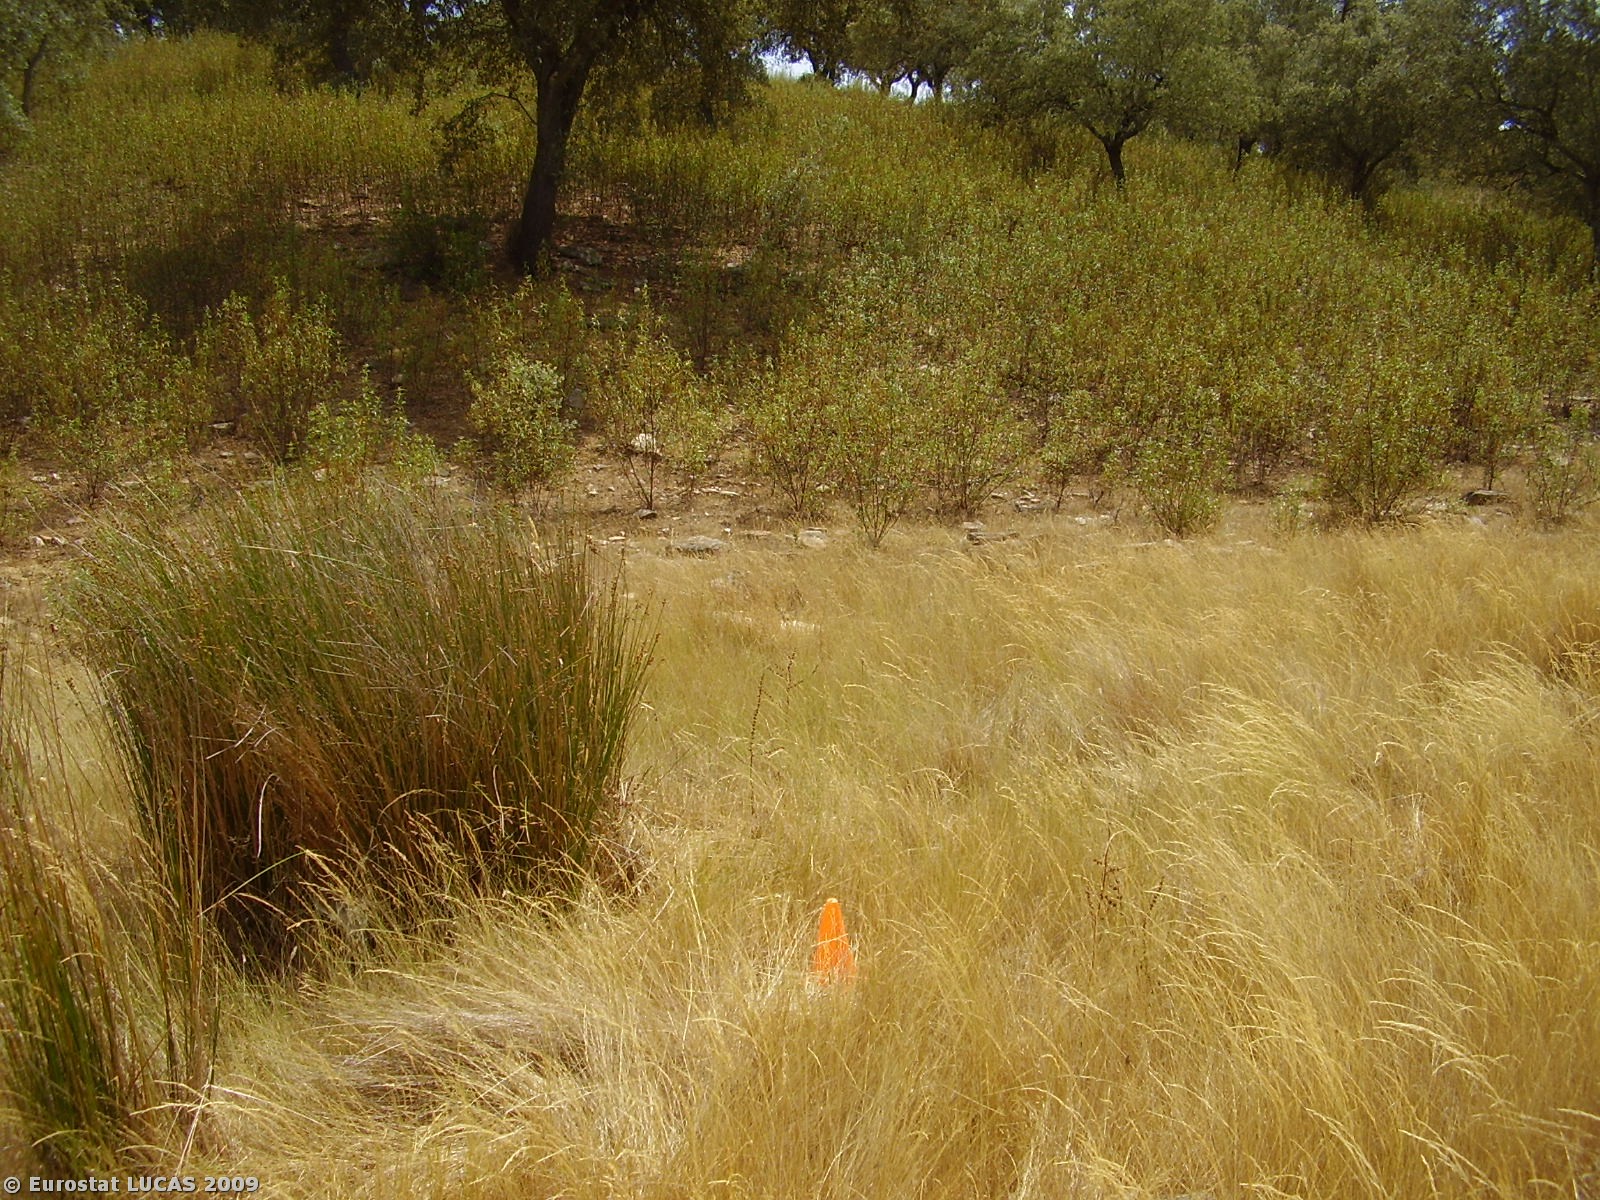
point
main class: Grassland
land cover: Grassland with sparse tree/shrub cover
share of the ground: > 75 %
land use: Forestry
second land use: Agriculture (excluding fallow land and kitchen gardens)
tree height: > 5 m
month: July
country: PT
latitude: 38.5665
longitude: -7.8150
